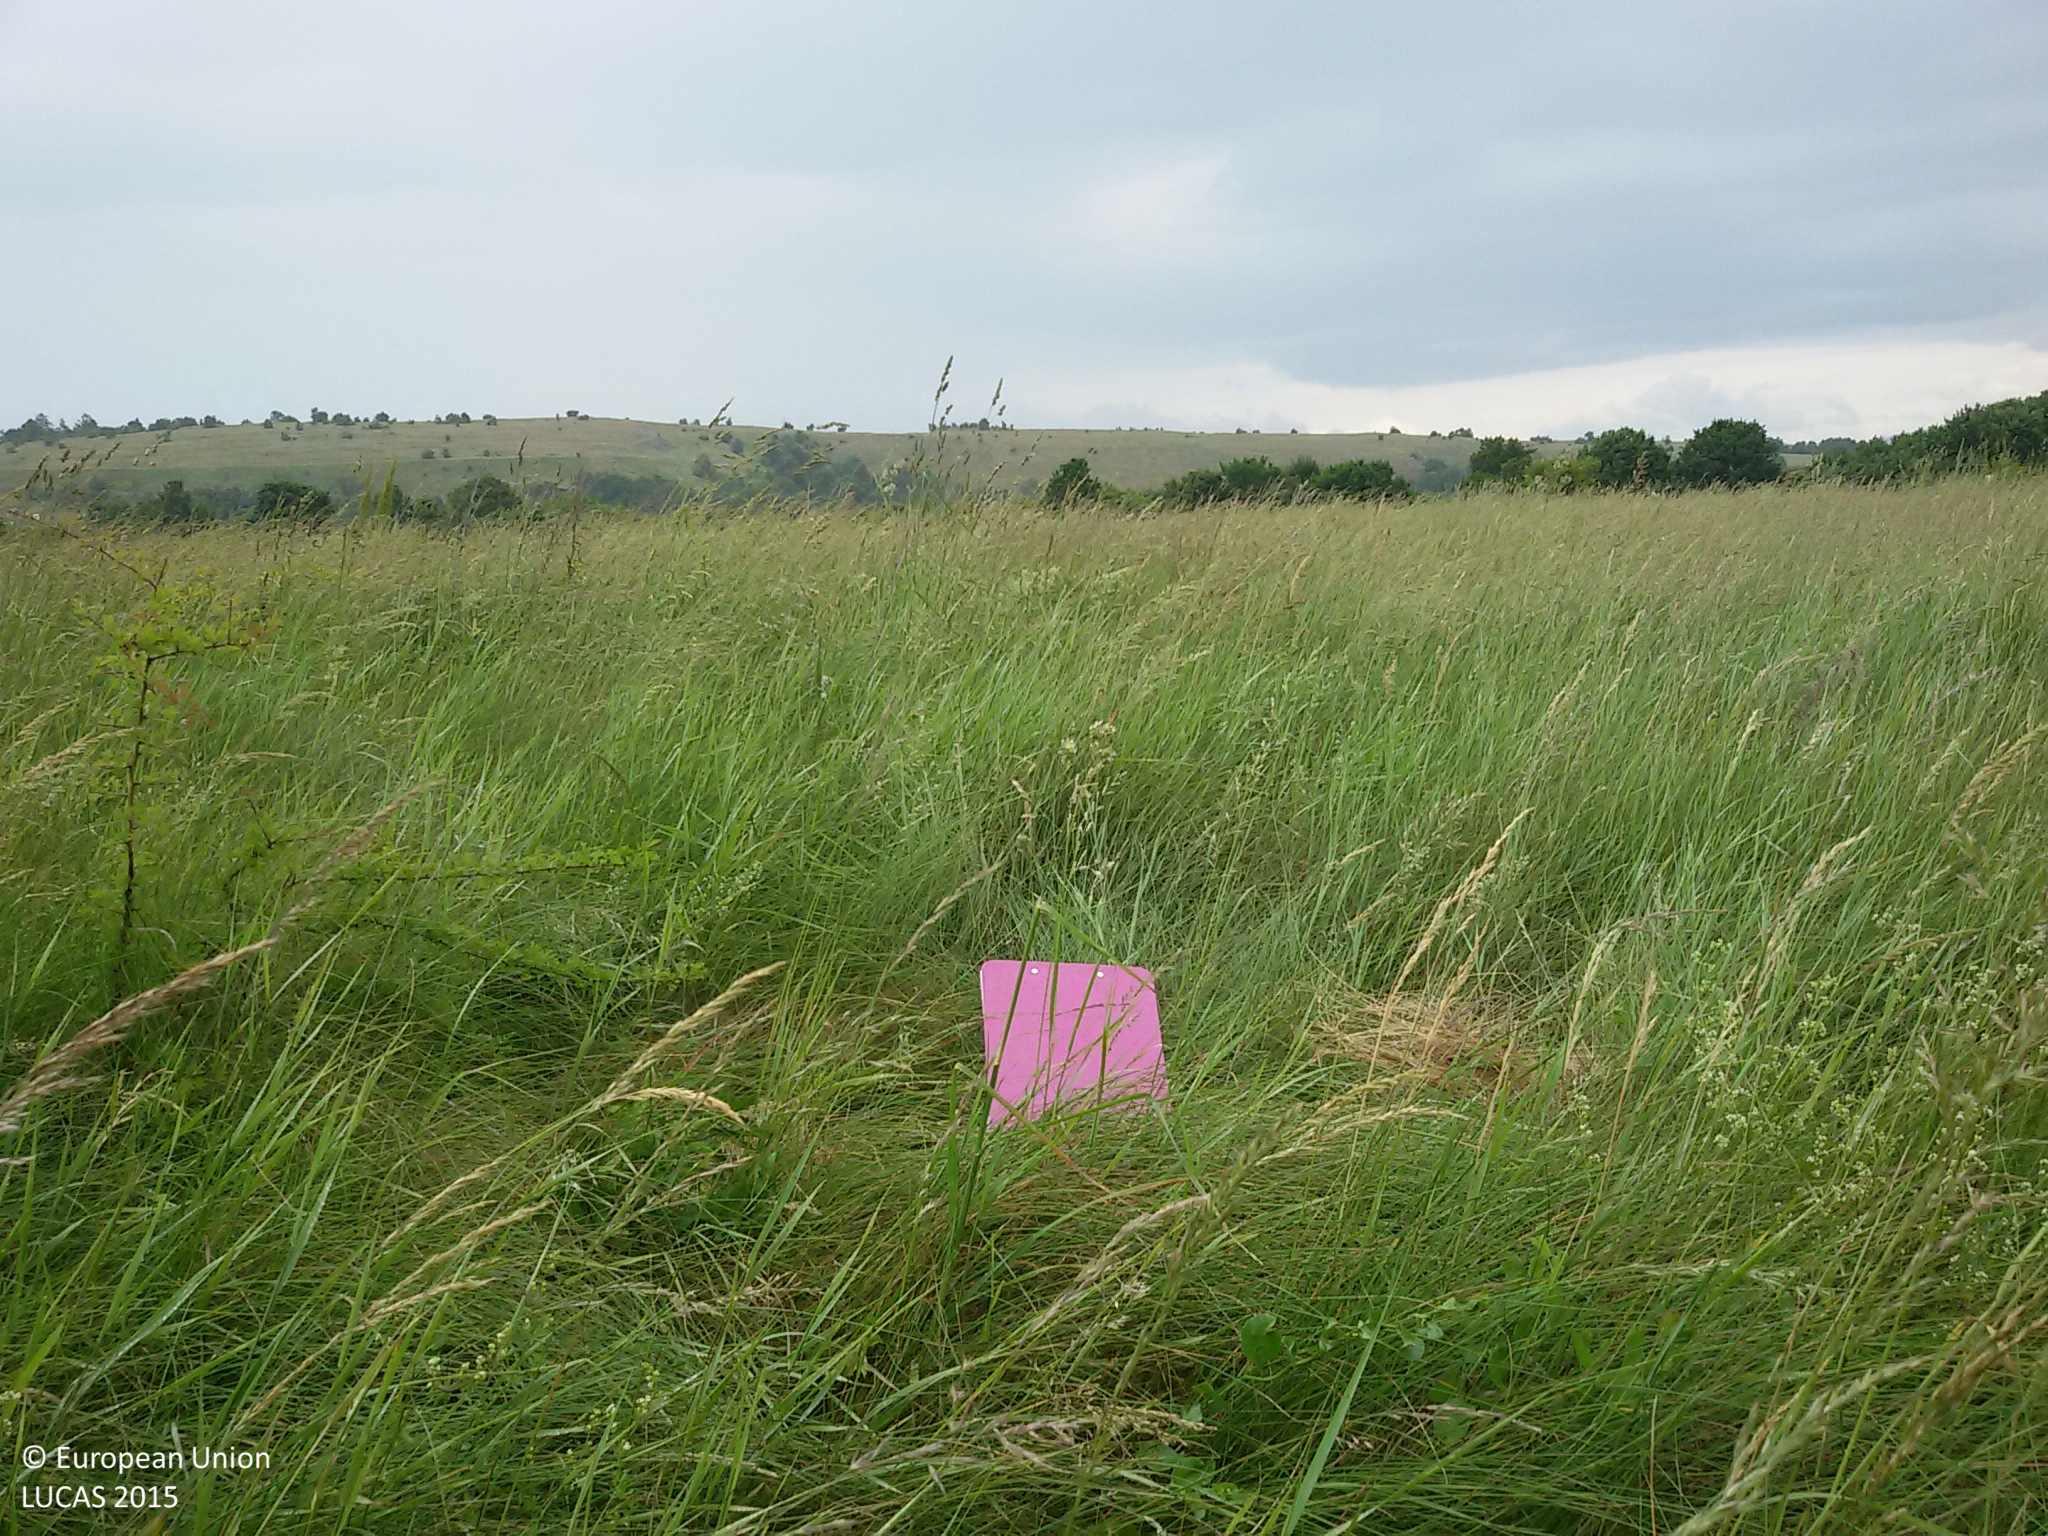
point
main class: Grassland
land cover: Grassland without tree/shrub cover
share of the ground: > 75 %
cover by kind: herbaceous plants 95 %, unconsolidated bare surface 5 %
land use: Agriculture (excluding fallow land and kitchen gardens)
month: June
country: HR
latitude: 44.6136
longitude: 15.6266
